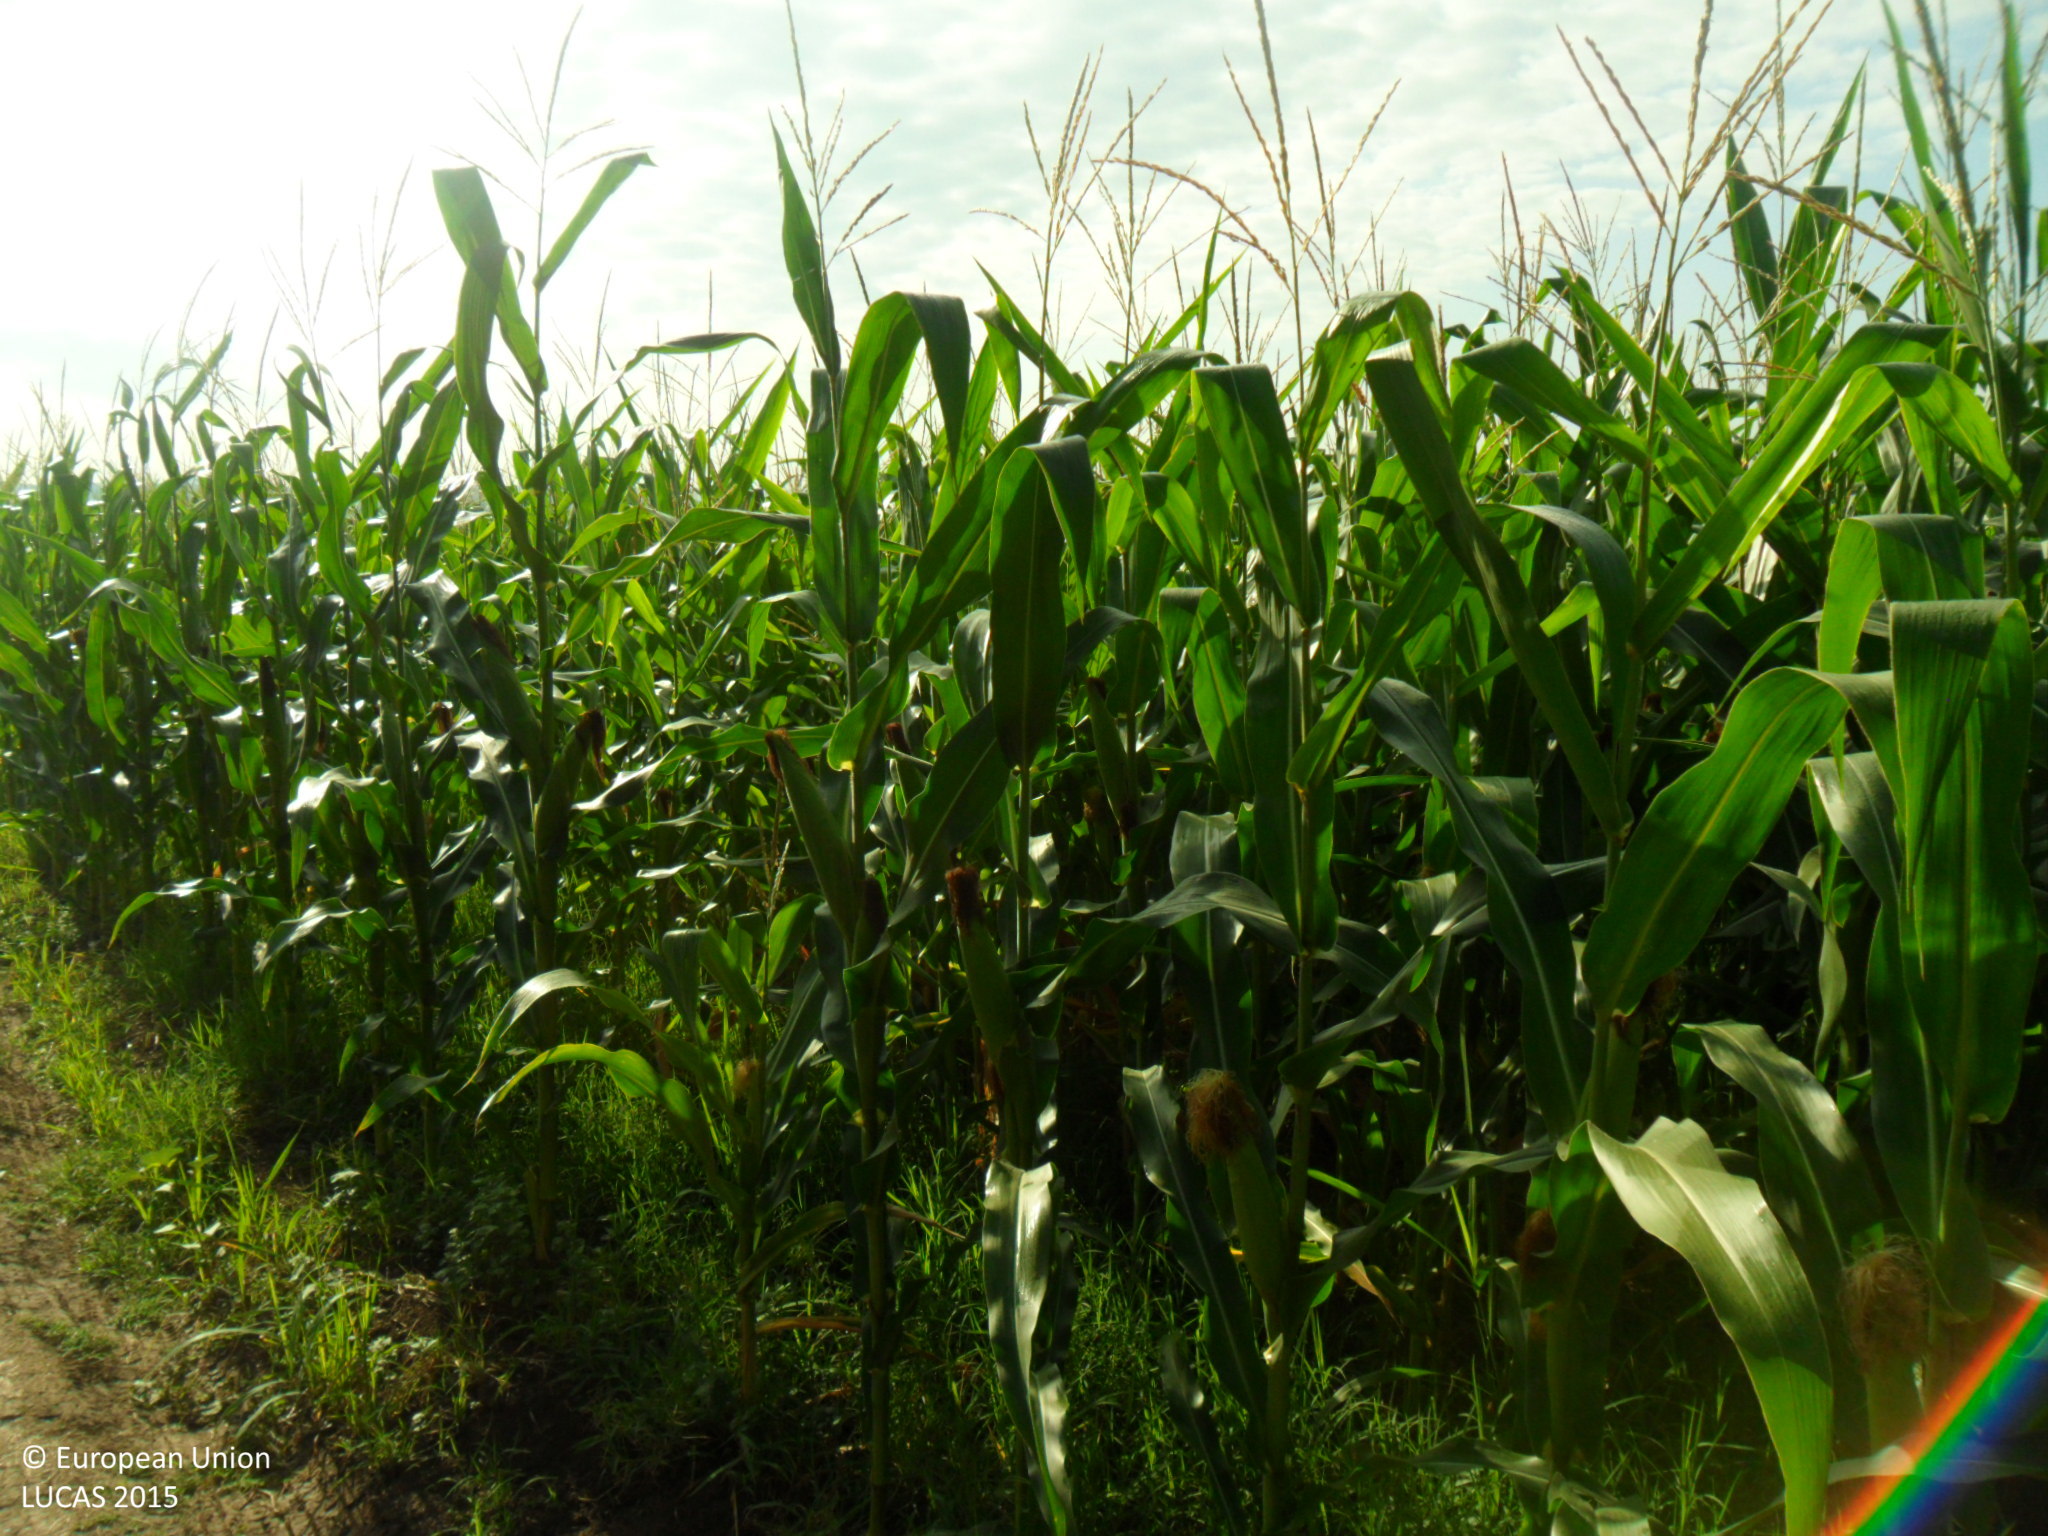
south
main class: Cropland
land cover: Maize
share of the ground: > 75 %
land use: Agriculture (excluding fallow land and kitchen gardens)
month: July
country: BG
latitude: 43.1914
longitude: 27.0086
